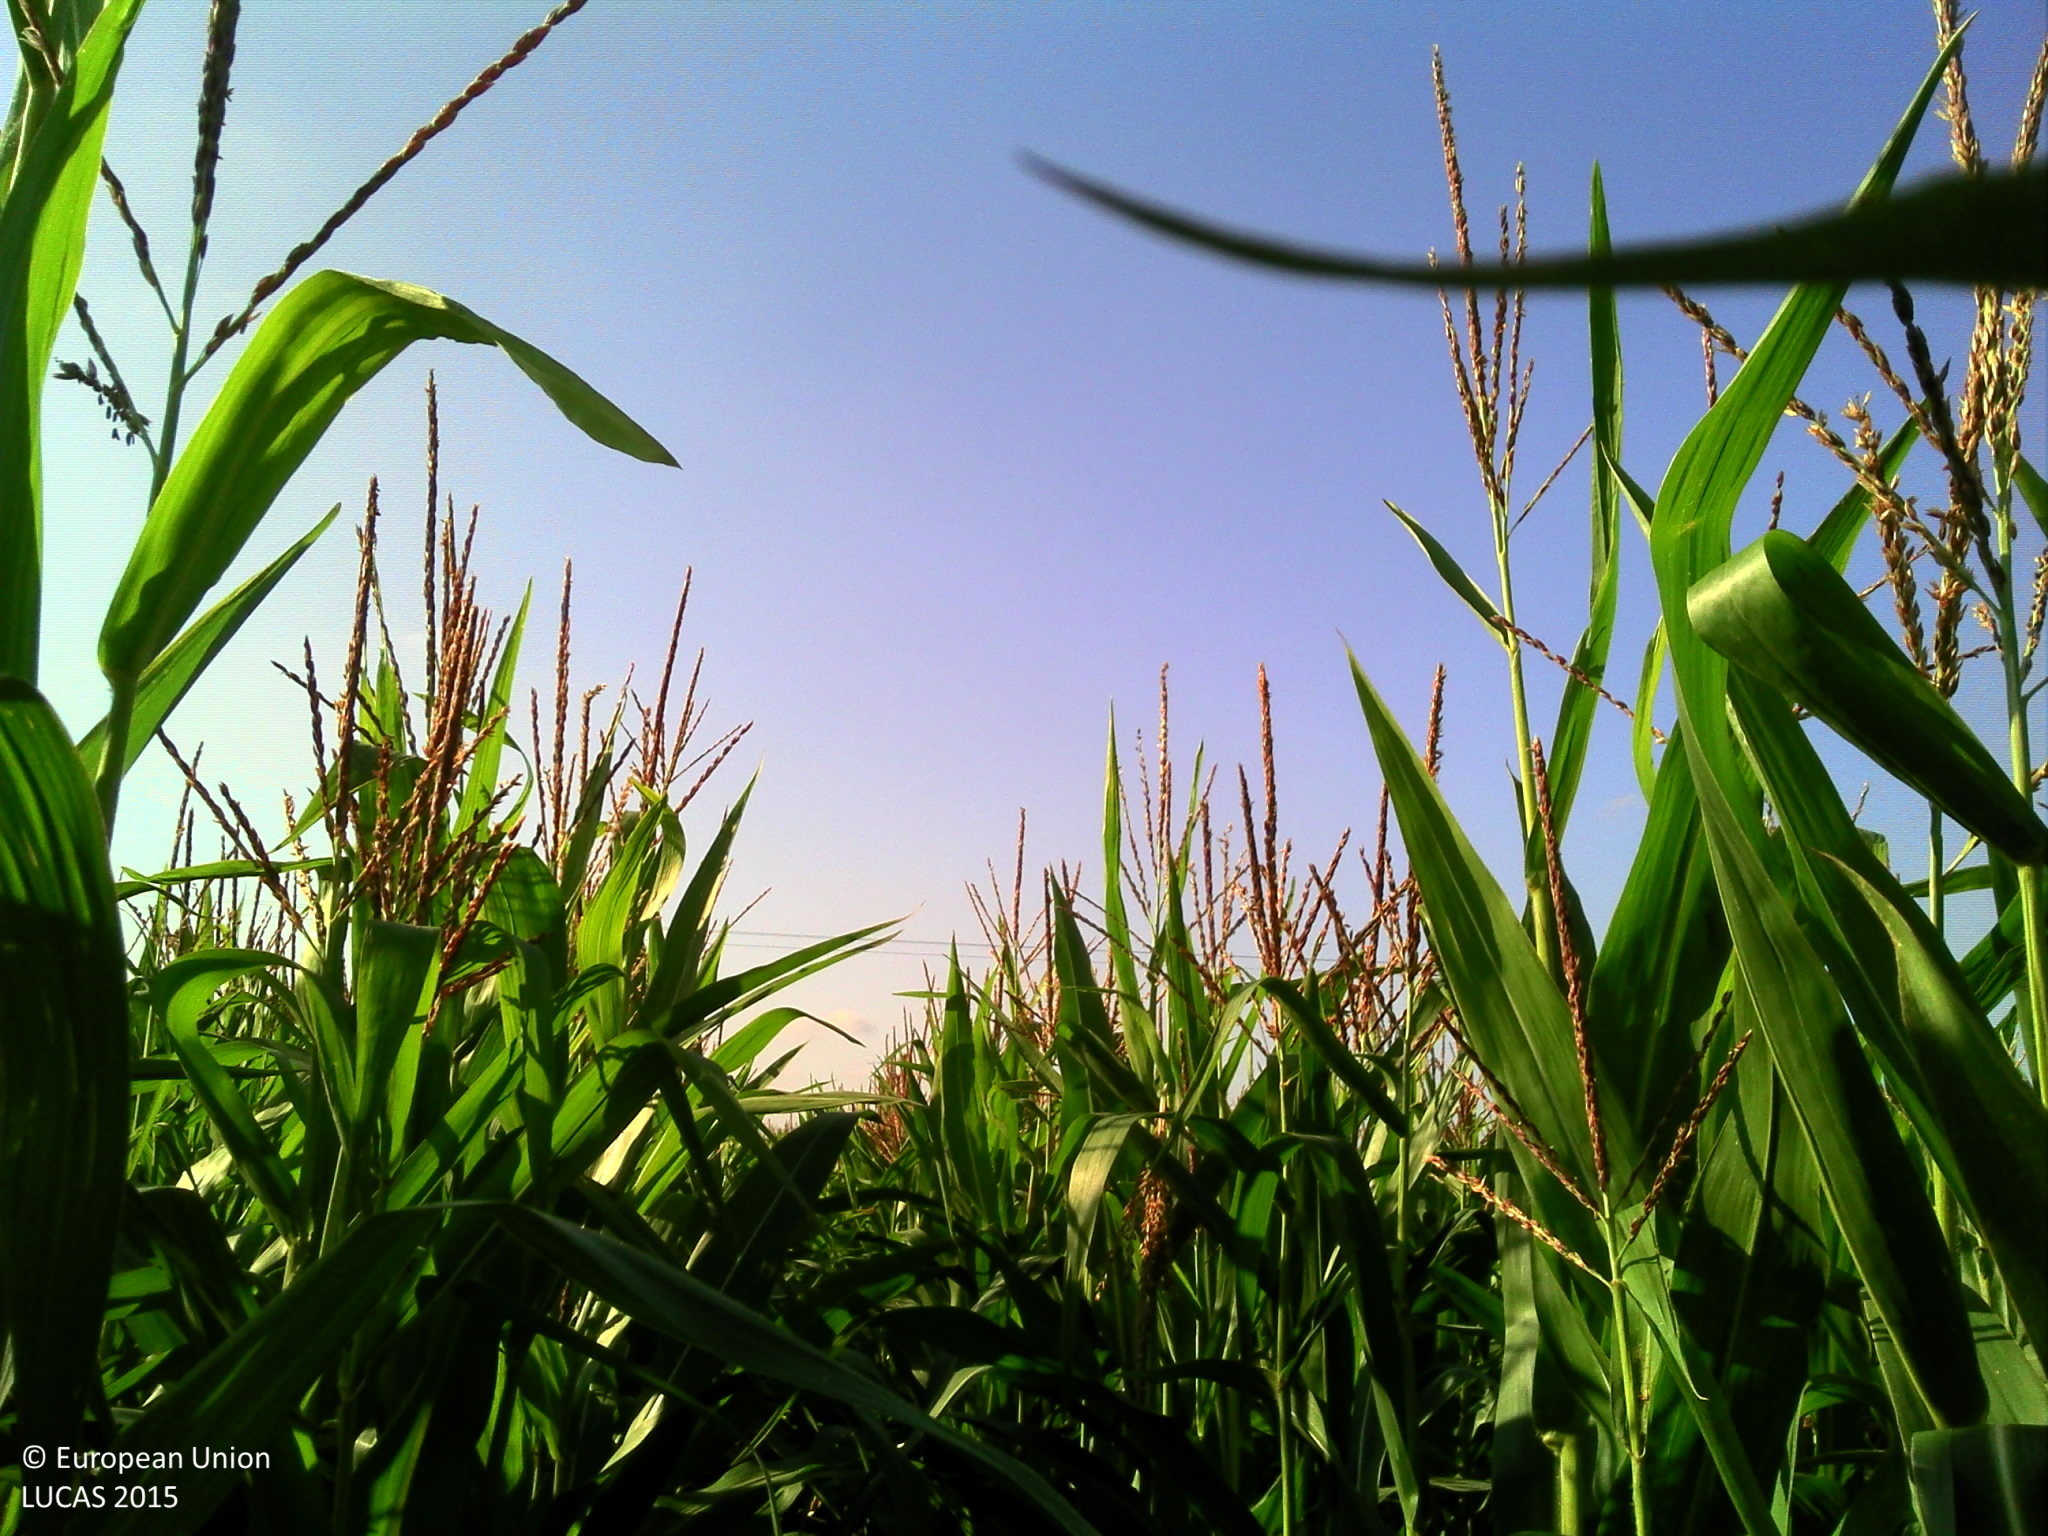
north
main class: Cropland
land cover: Maize
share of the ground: > 75 %
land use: Agriculture (excluding fallow land and kitchen gardens)
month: August
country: FR
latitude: 48.3155
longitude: -1.9599
